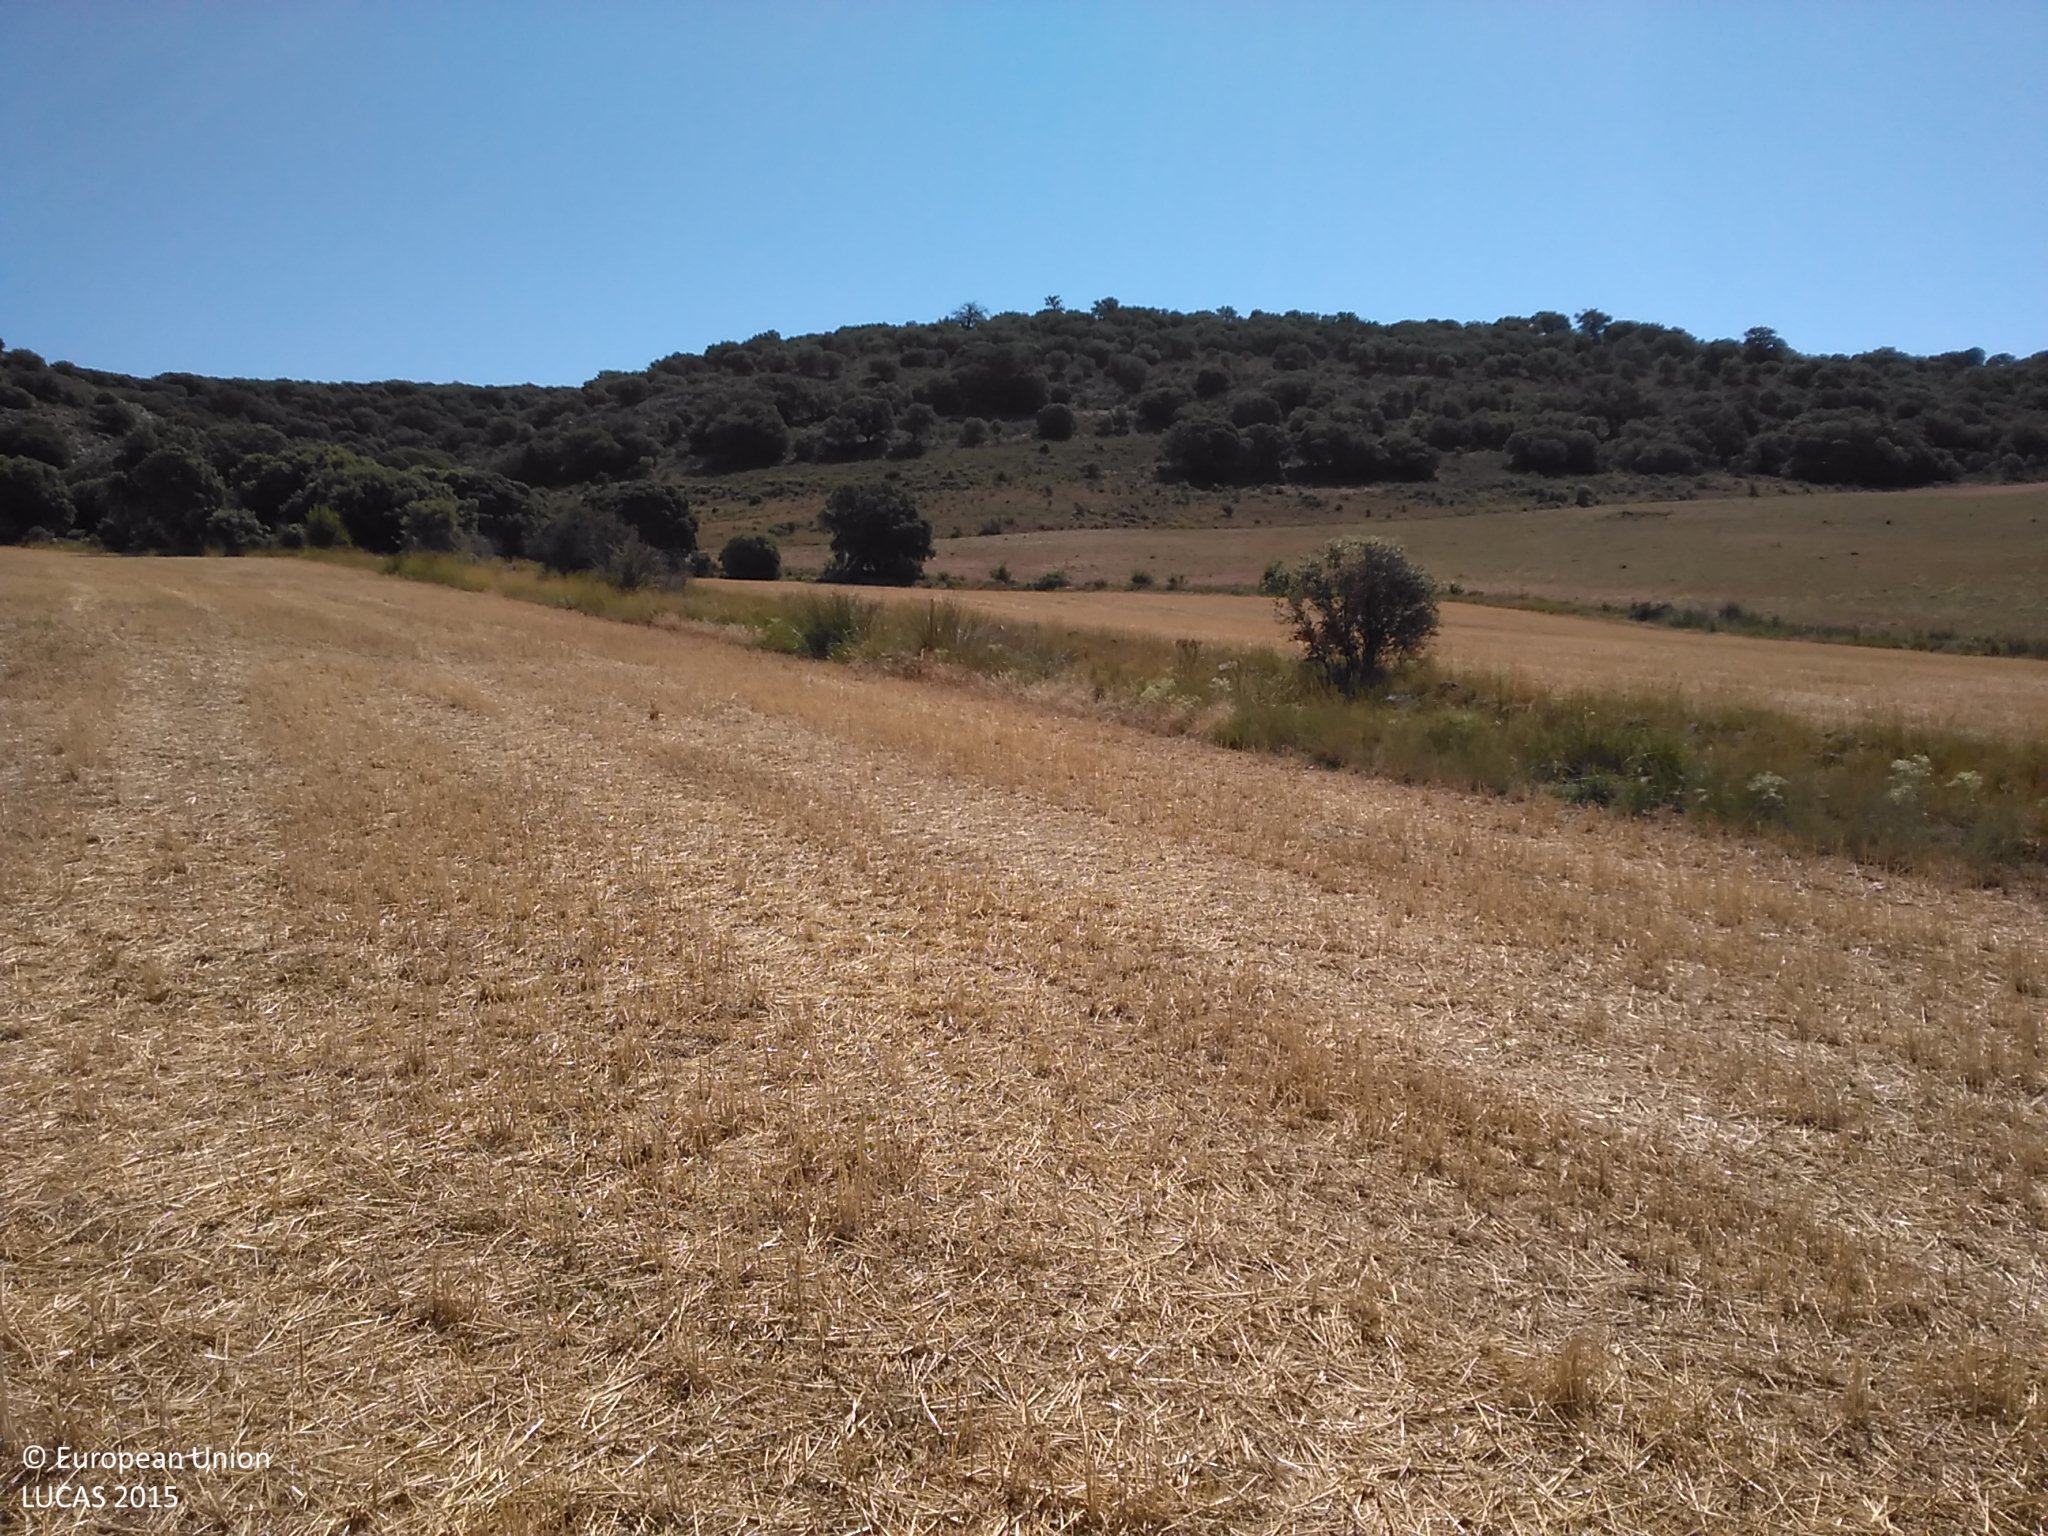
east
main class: Cropland
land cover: Common wheat
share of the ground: < 10 %
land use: Agriculture (excluding fallow land and kitchen gardens)
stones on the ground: < 10 %
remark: Harvested field
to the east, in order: Common wheat; Grass margins; Tracks; Grass margins; Common wheat; Single bushes/trees; Spontaneously vegetated surfaces
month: July
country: ES
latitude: 41.5566
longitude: -1.9846
